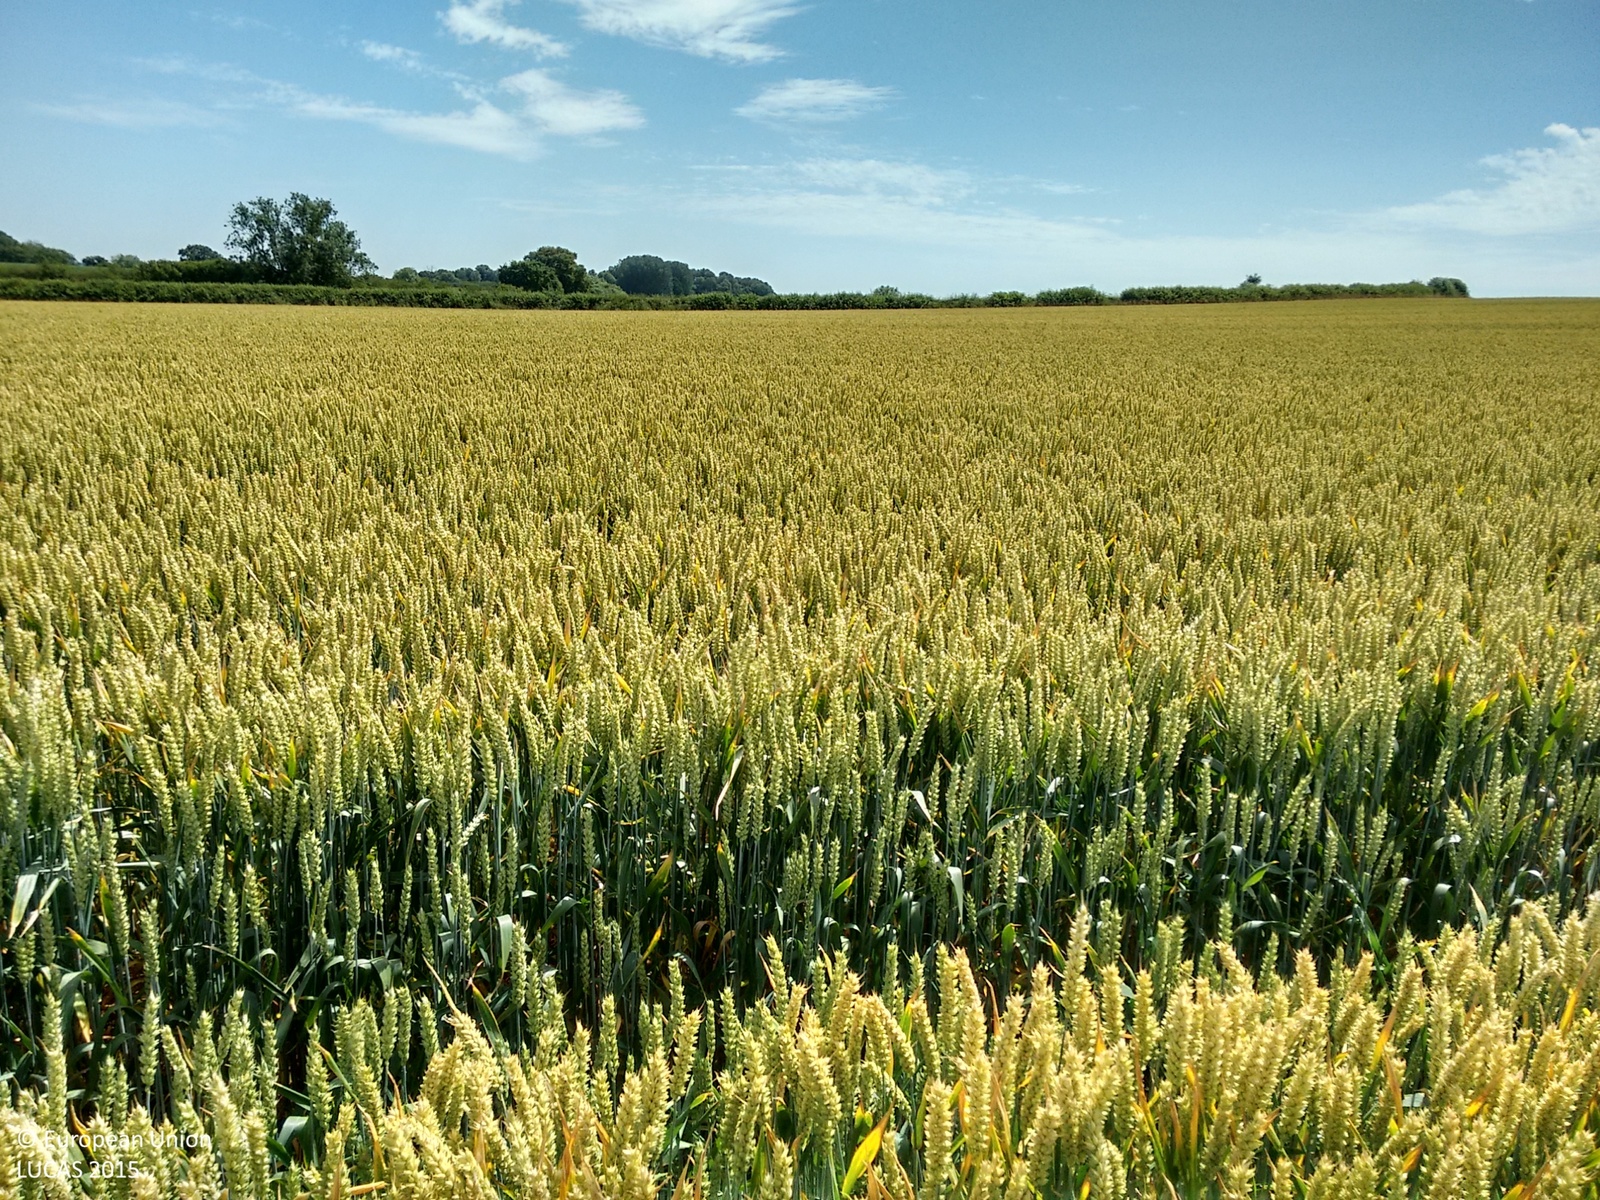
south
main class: Cropland
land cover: Common wheat
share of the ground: > 75 %
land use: Agriculture (excluding fallow land and kitchen gardens)
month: July
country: GB
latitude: 51.6851
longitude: -1.1697
